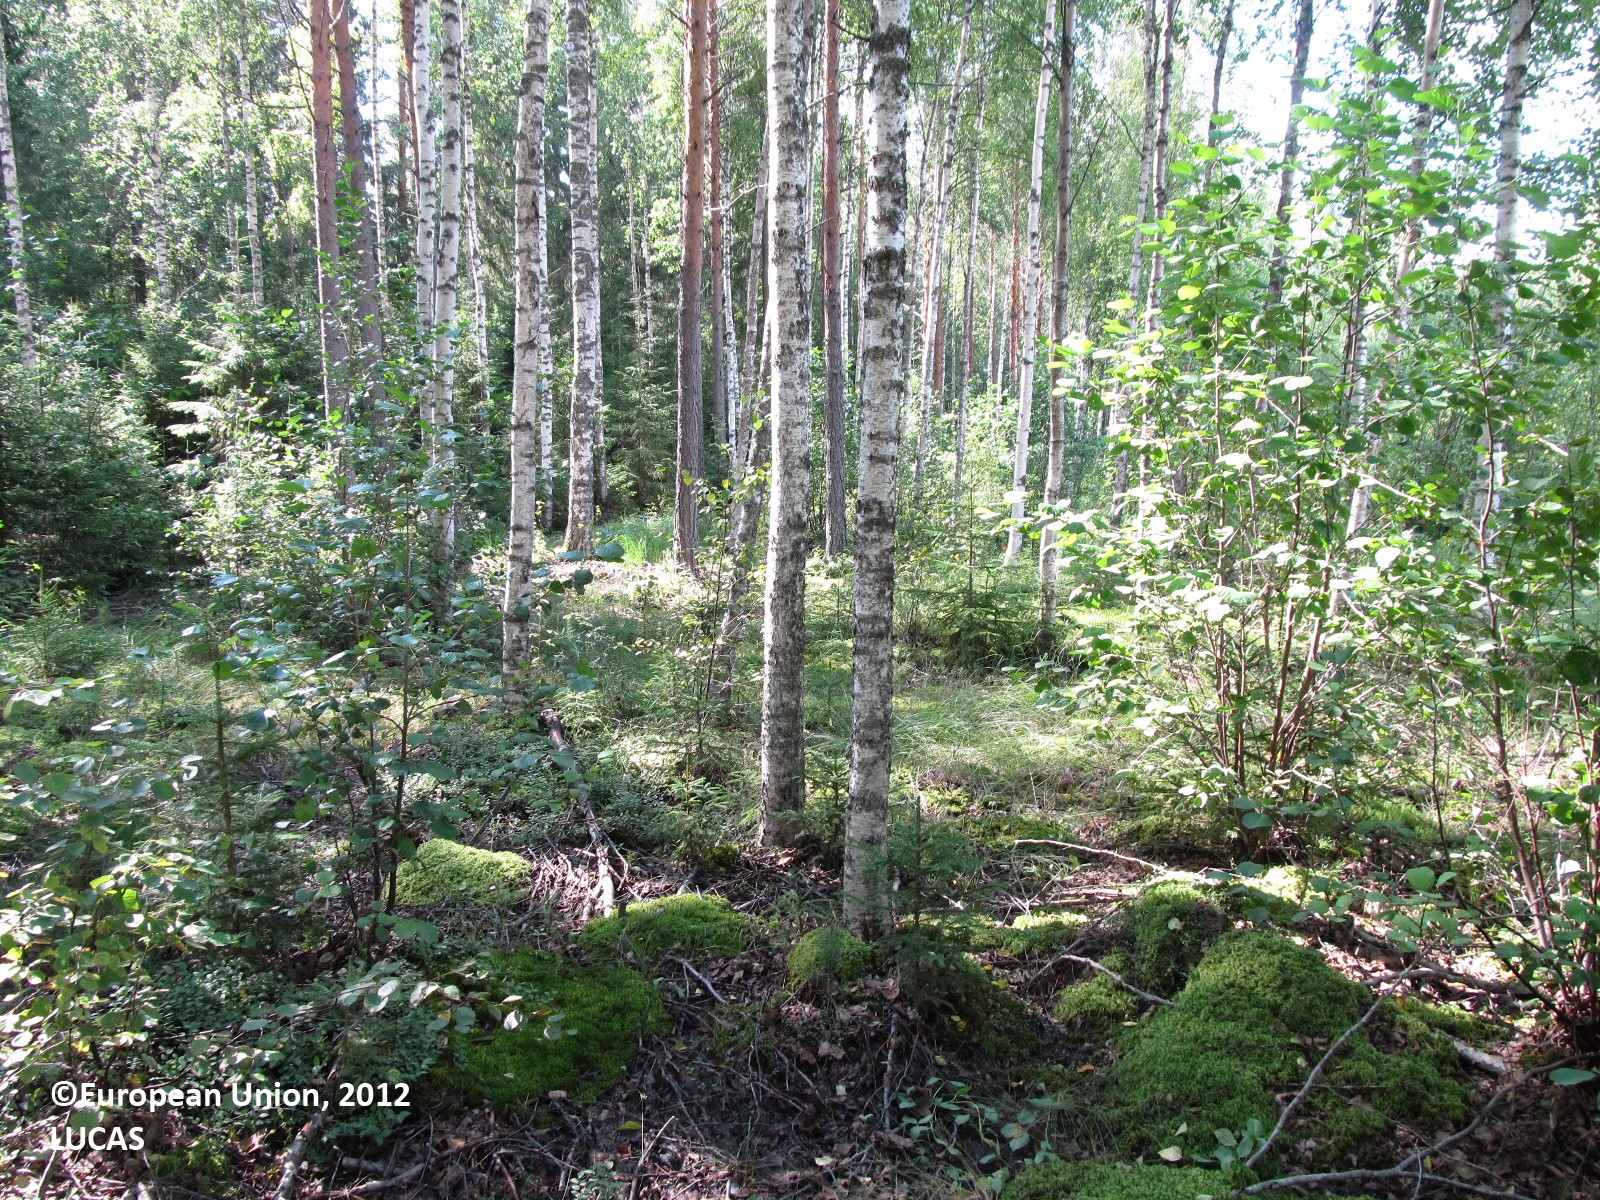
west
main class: Woodland
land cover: Pine dominated mixed woodland
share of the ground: 25 - 50 %
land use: Forestry
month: July
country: FI
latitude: 62.0858
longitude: 28.1738
